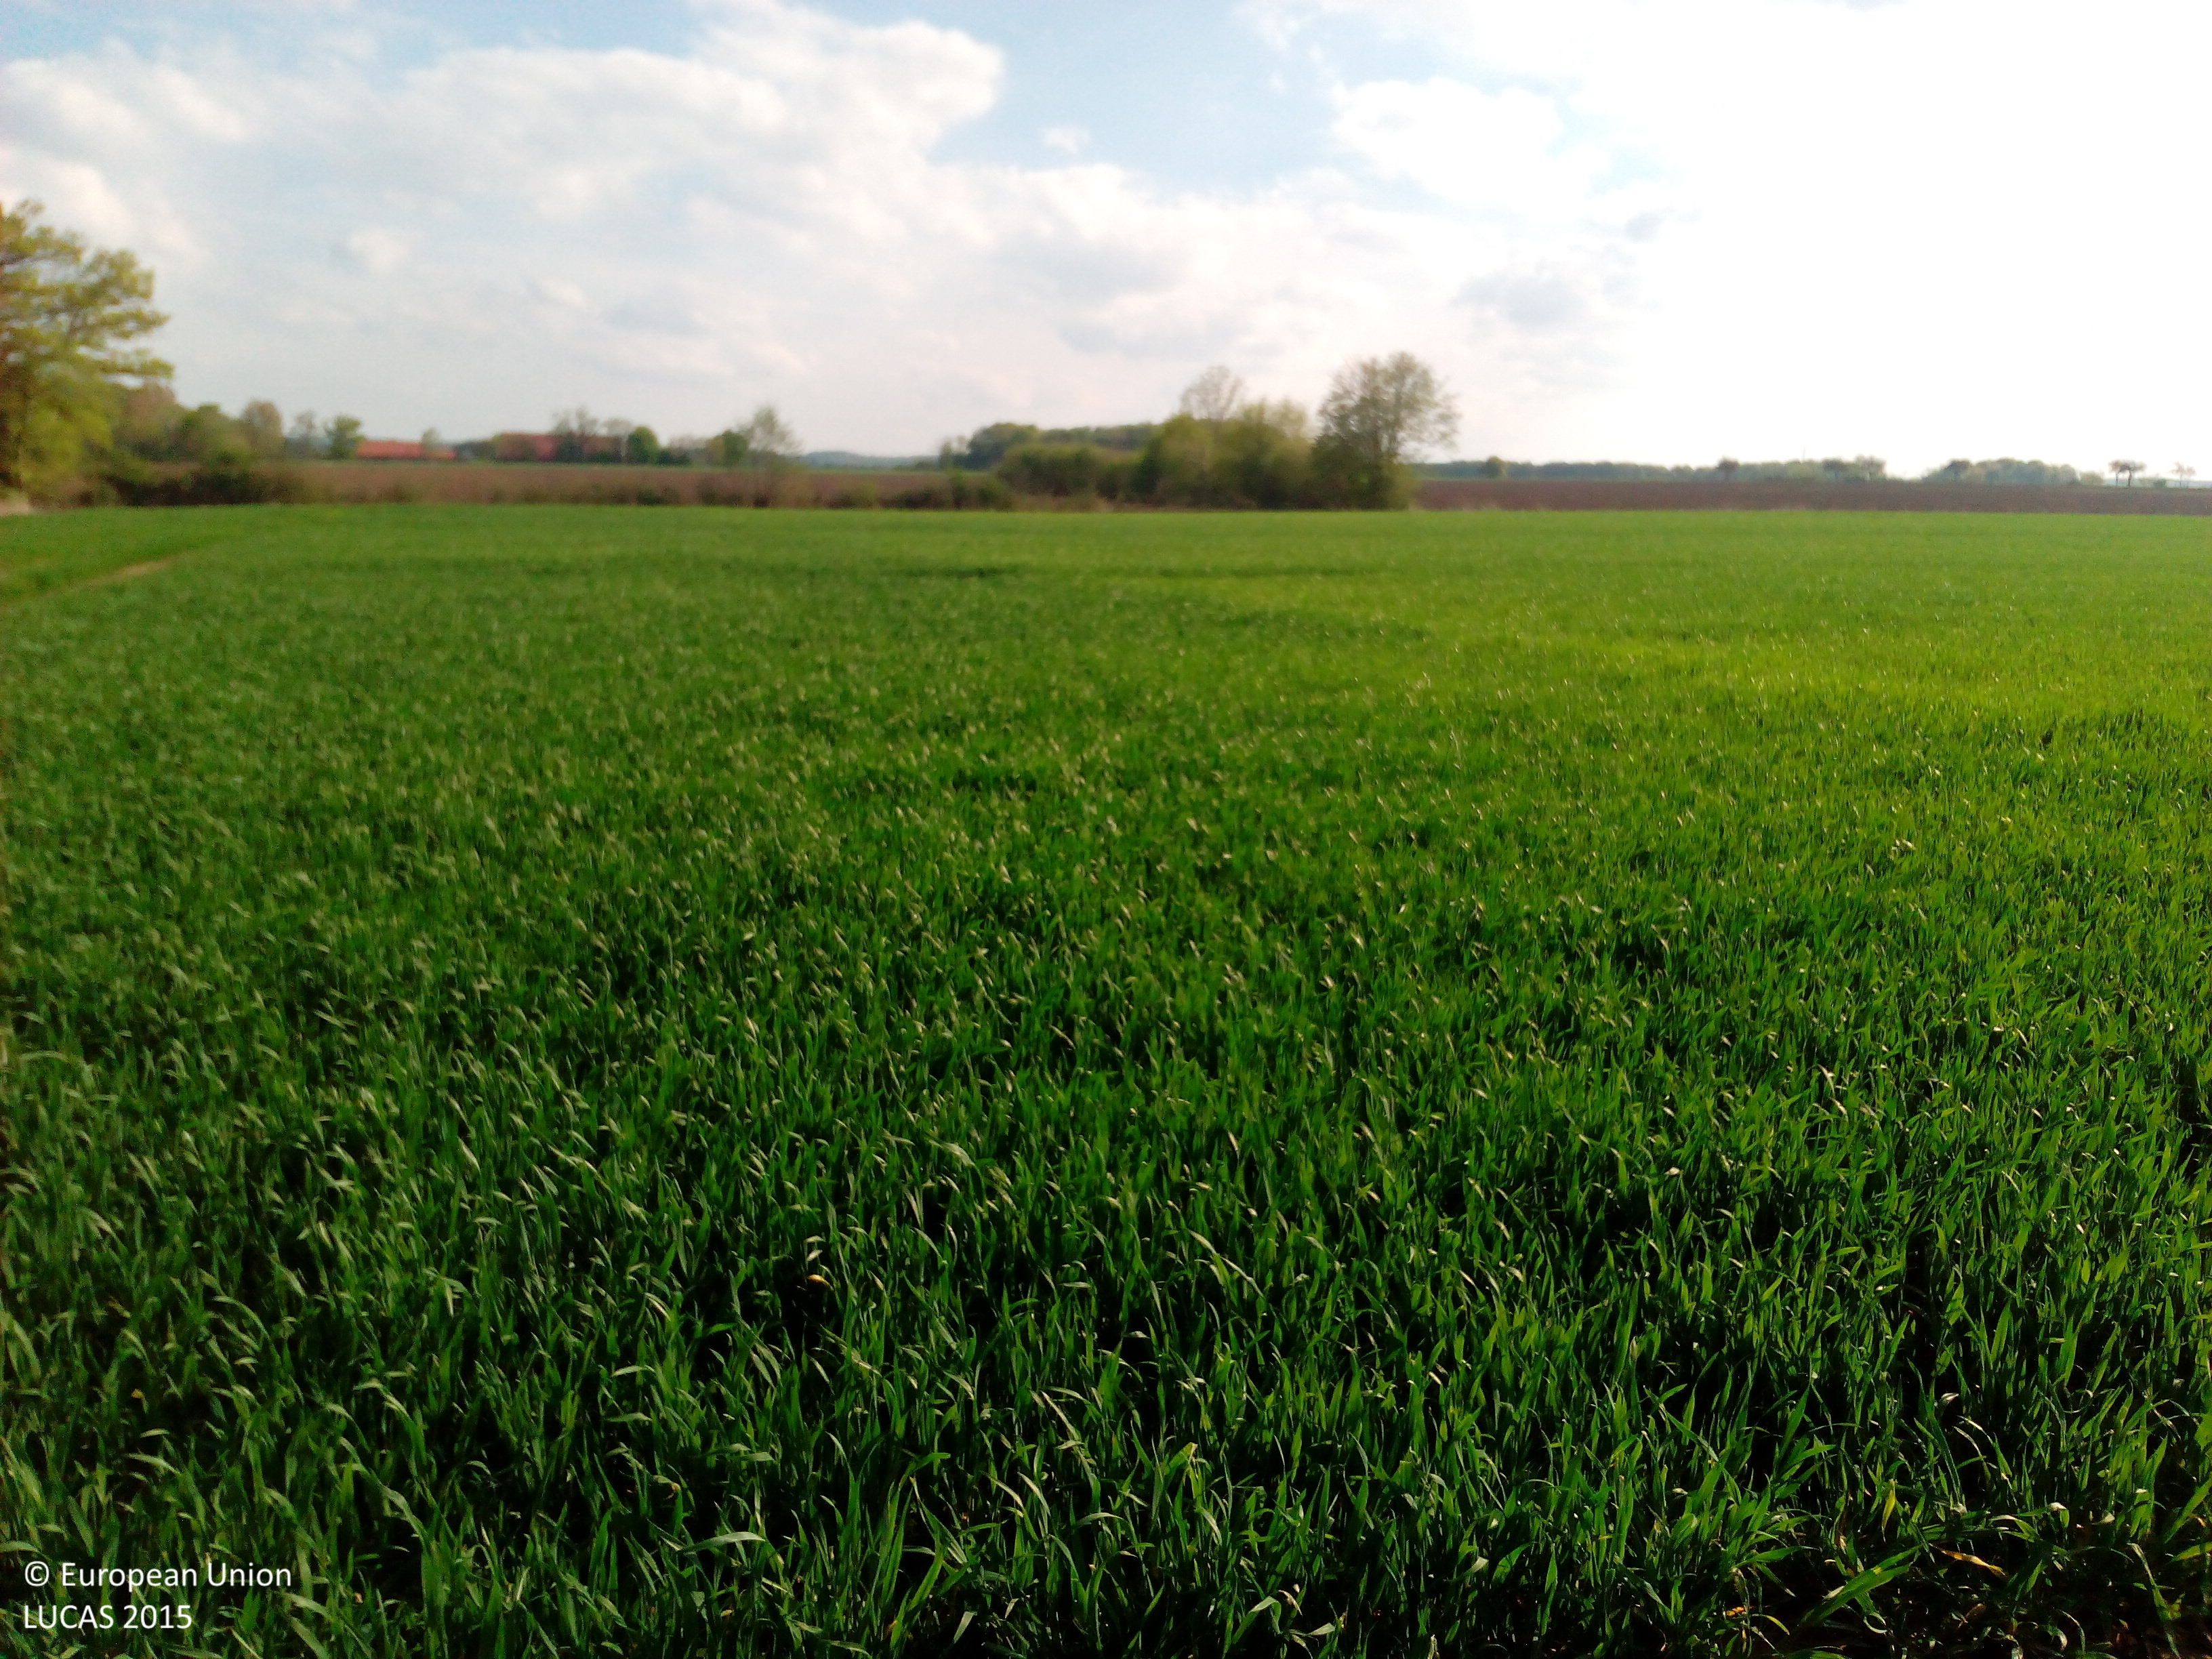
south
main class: Cropland
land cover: Triticale
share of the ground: > 75 %
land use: Agriculture (excluding fallow land and kitchen gardens)
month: May
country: DE
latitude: 52.0251
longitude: 7.3915
